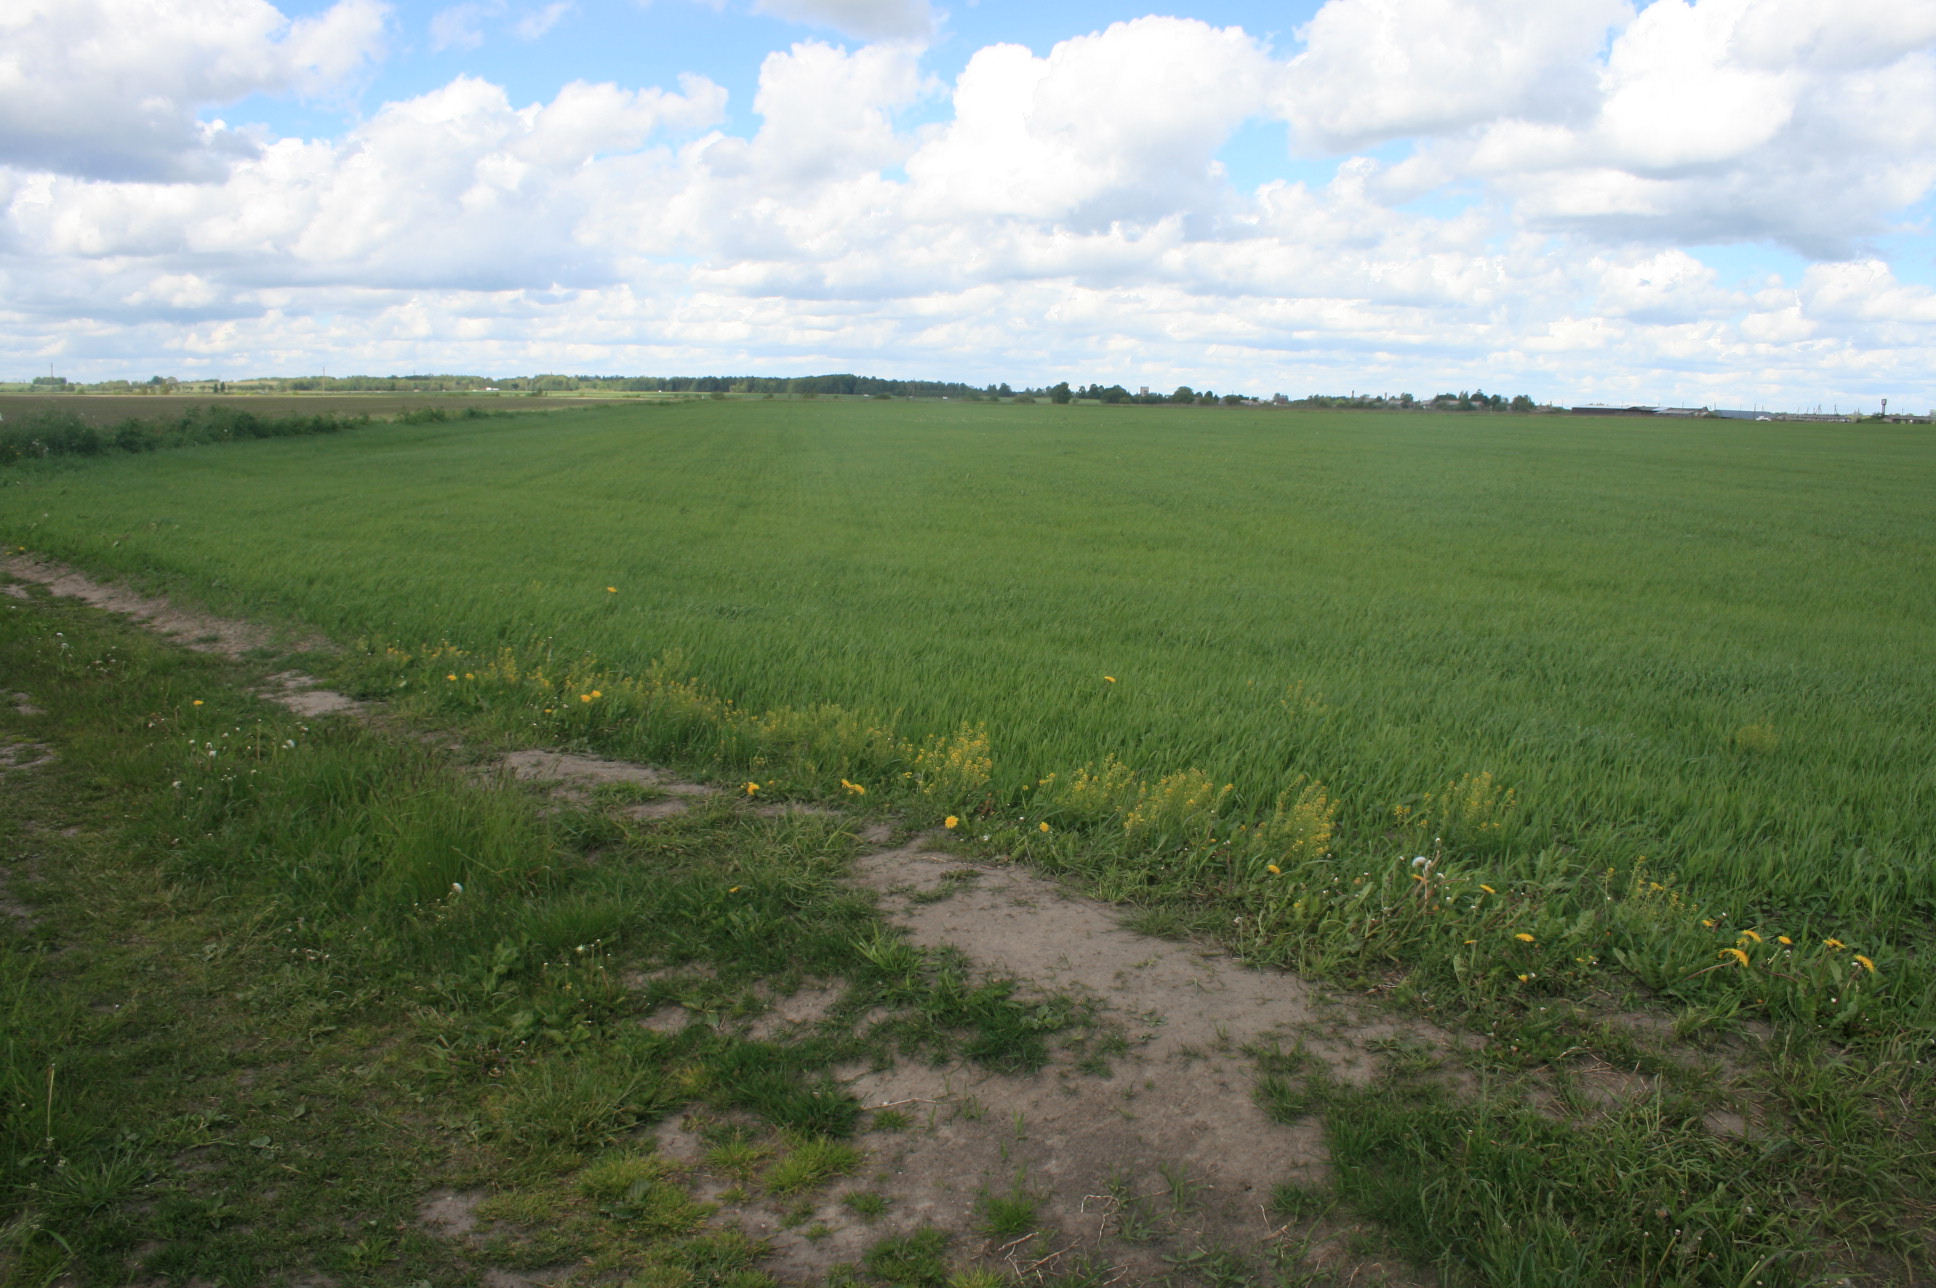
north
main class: Cropland
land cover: Oats
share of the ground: > 75 %
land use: Agriculture (excluding fallow land and kitchen gardens)
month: May
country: LT
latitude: 55.9888
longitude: 22.3520
